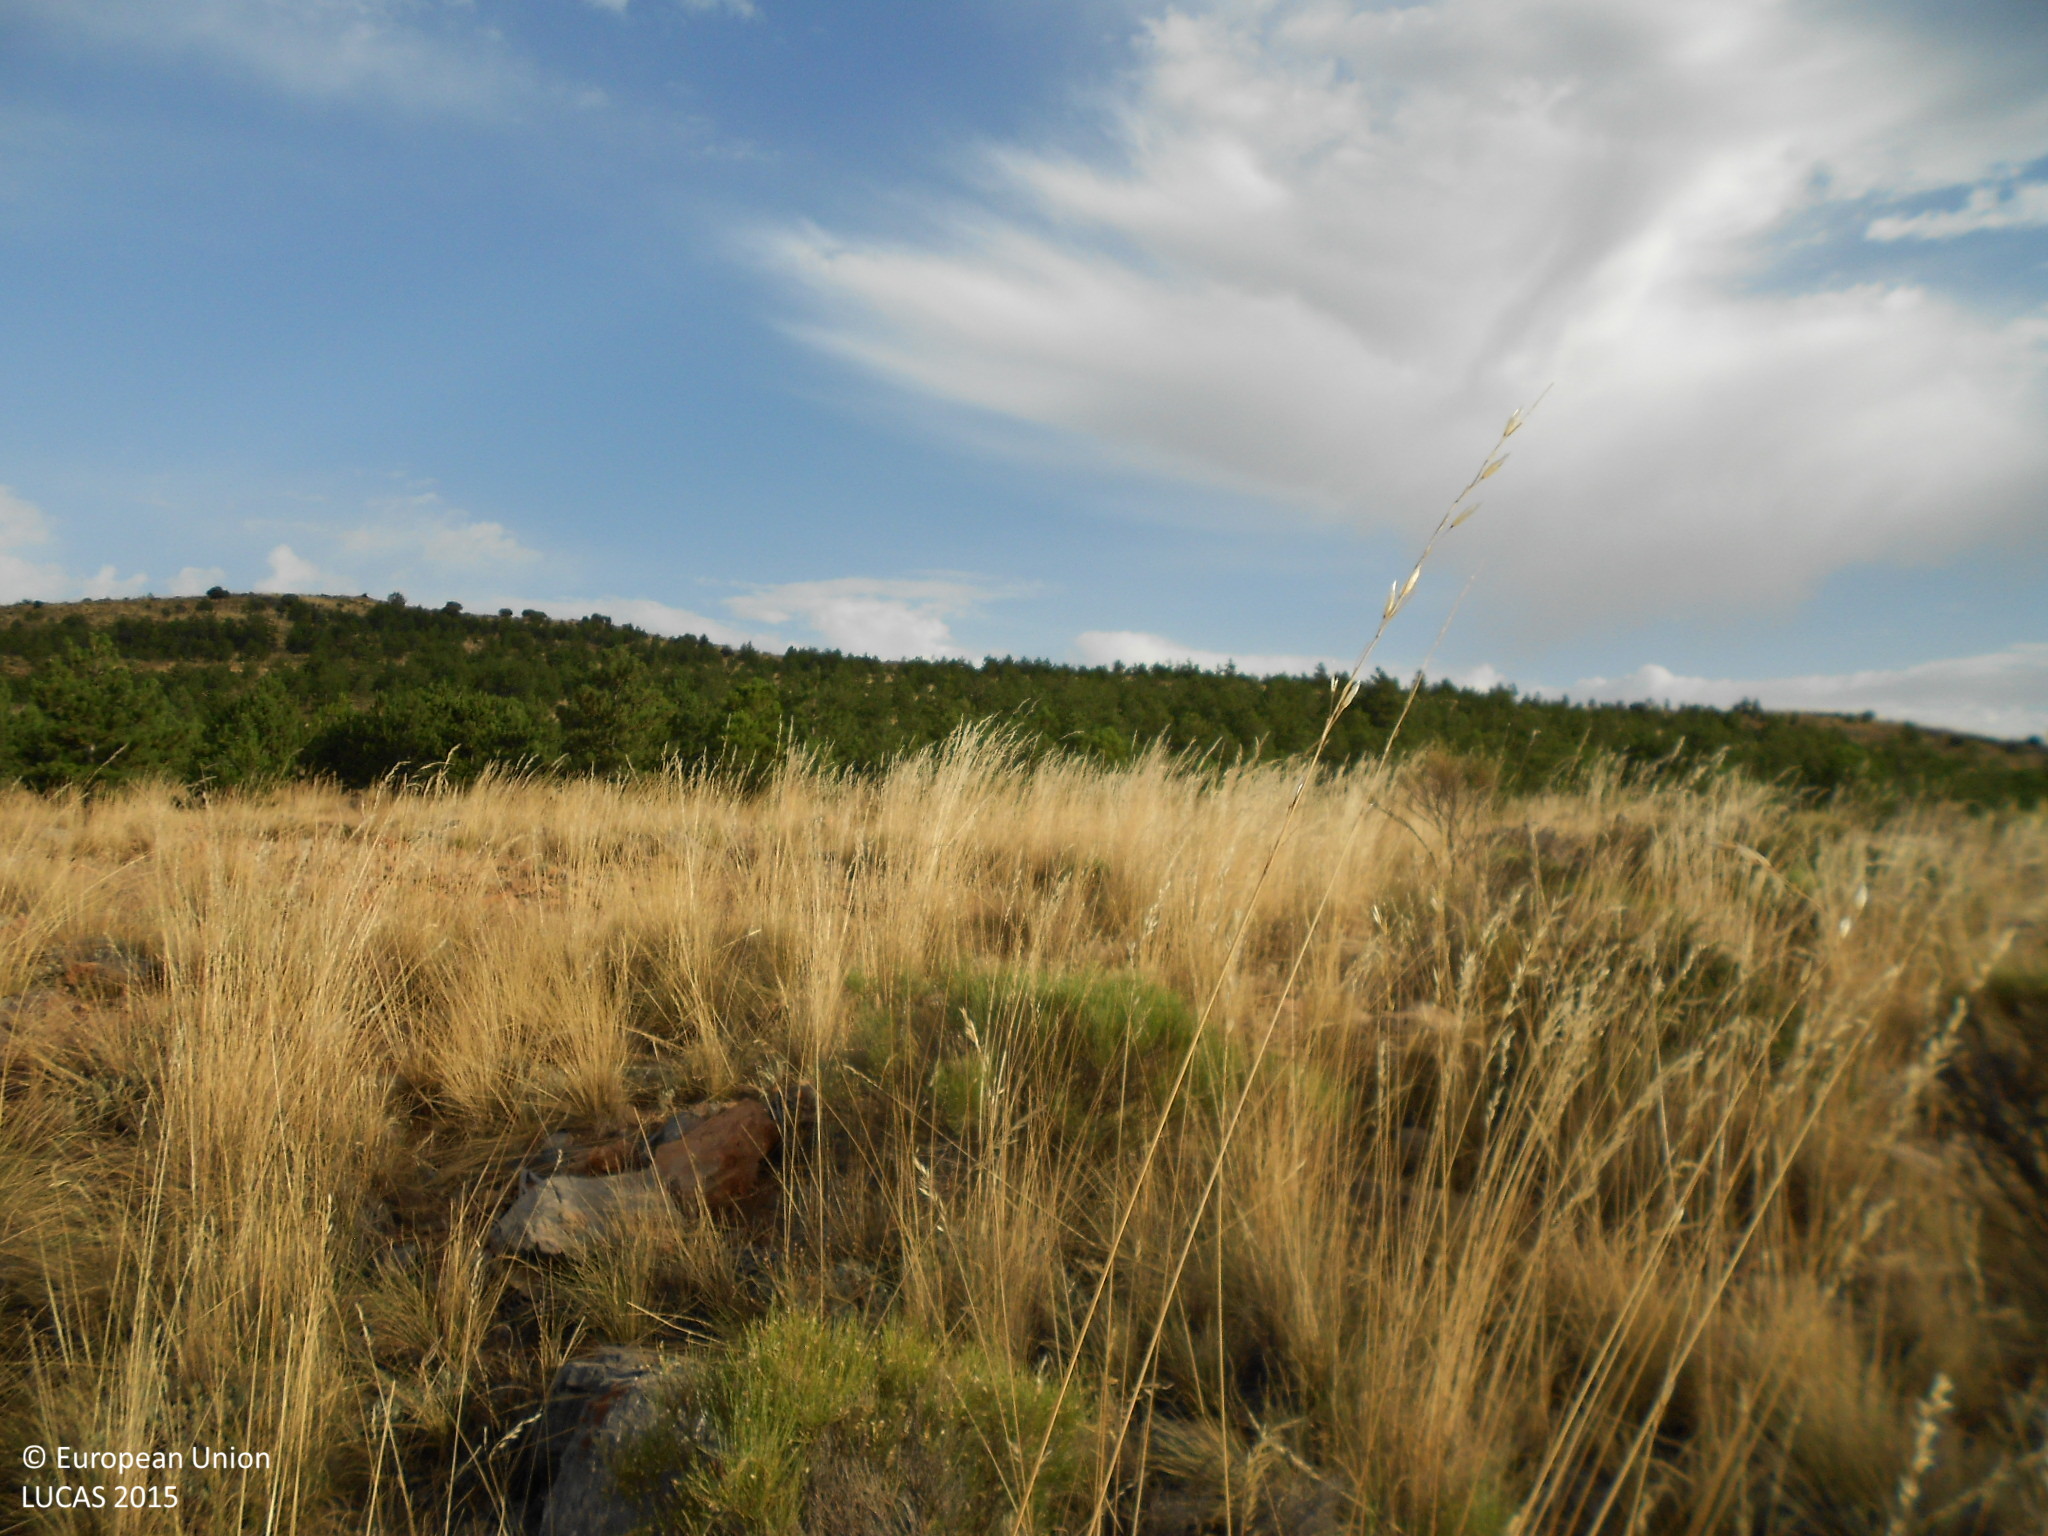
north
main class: Shrubland
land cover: Shrubland without tree cover
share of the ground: 10 - 25 %
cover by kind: herbaceous plants 80 %, shrubs 20 %
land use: Semi-natural and natural areas not in use
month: July
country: ES
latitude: 36.9173
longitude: -2.7860
